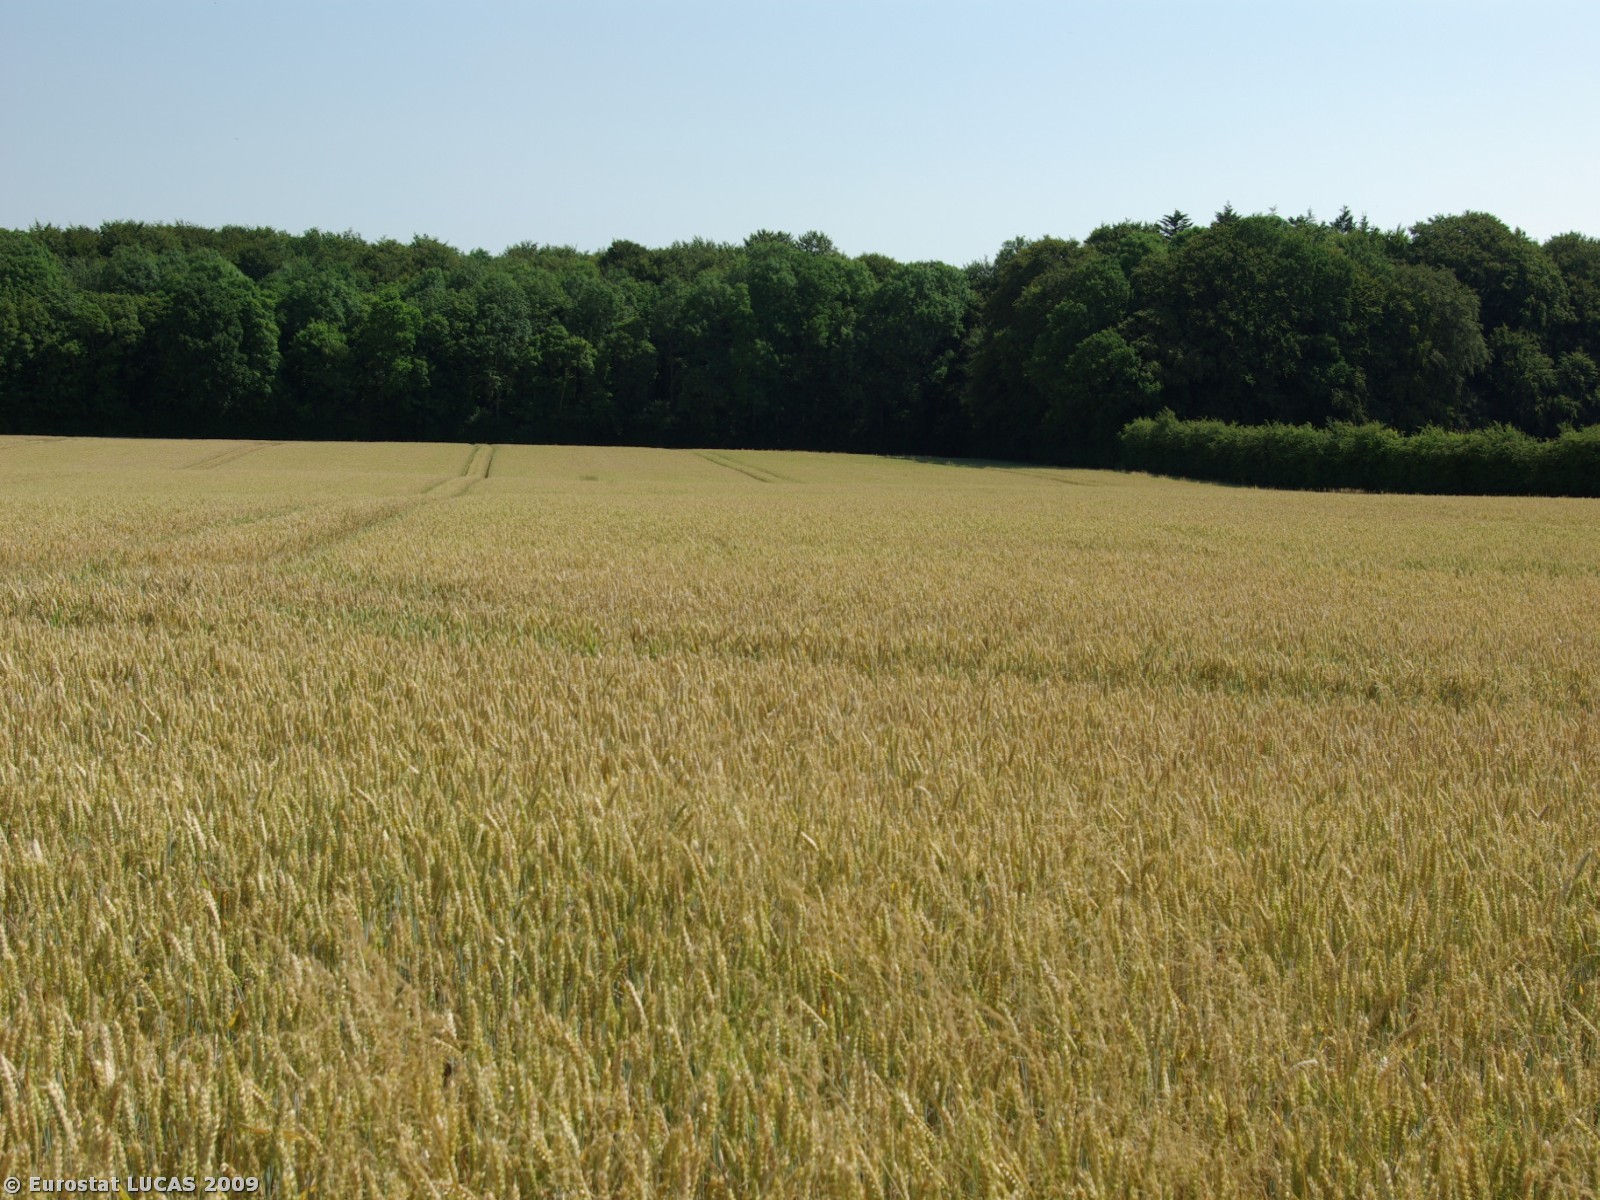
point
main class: Cropland
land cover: Common wheat
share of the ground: > 75 %
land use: Agriculture (excluding fallow land and kitchen gardens)
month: July
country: DK
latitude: 54.9652
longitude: 9.7347
